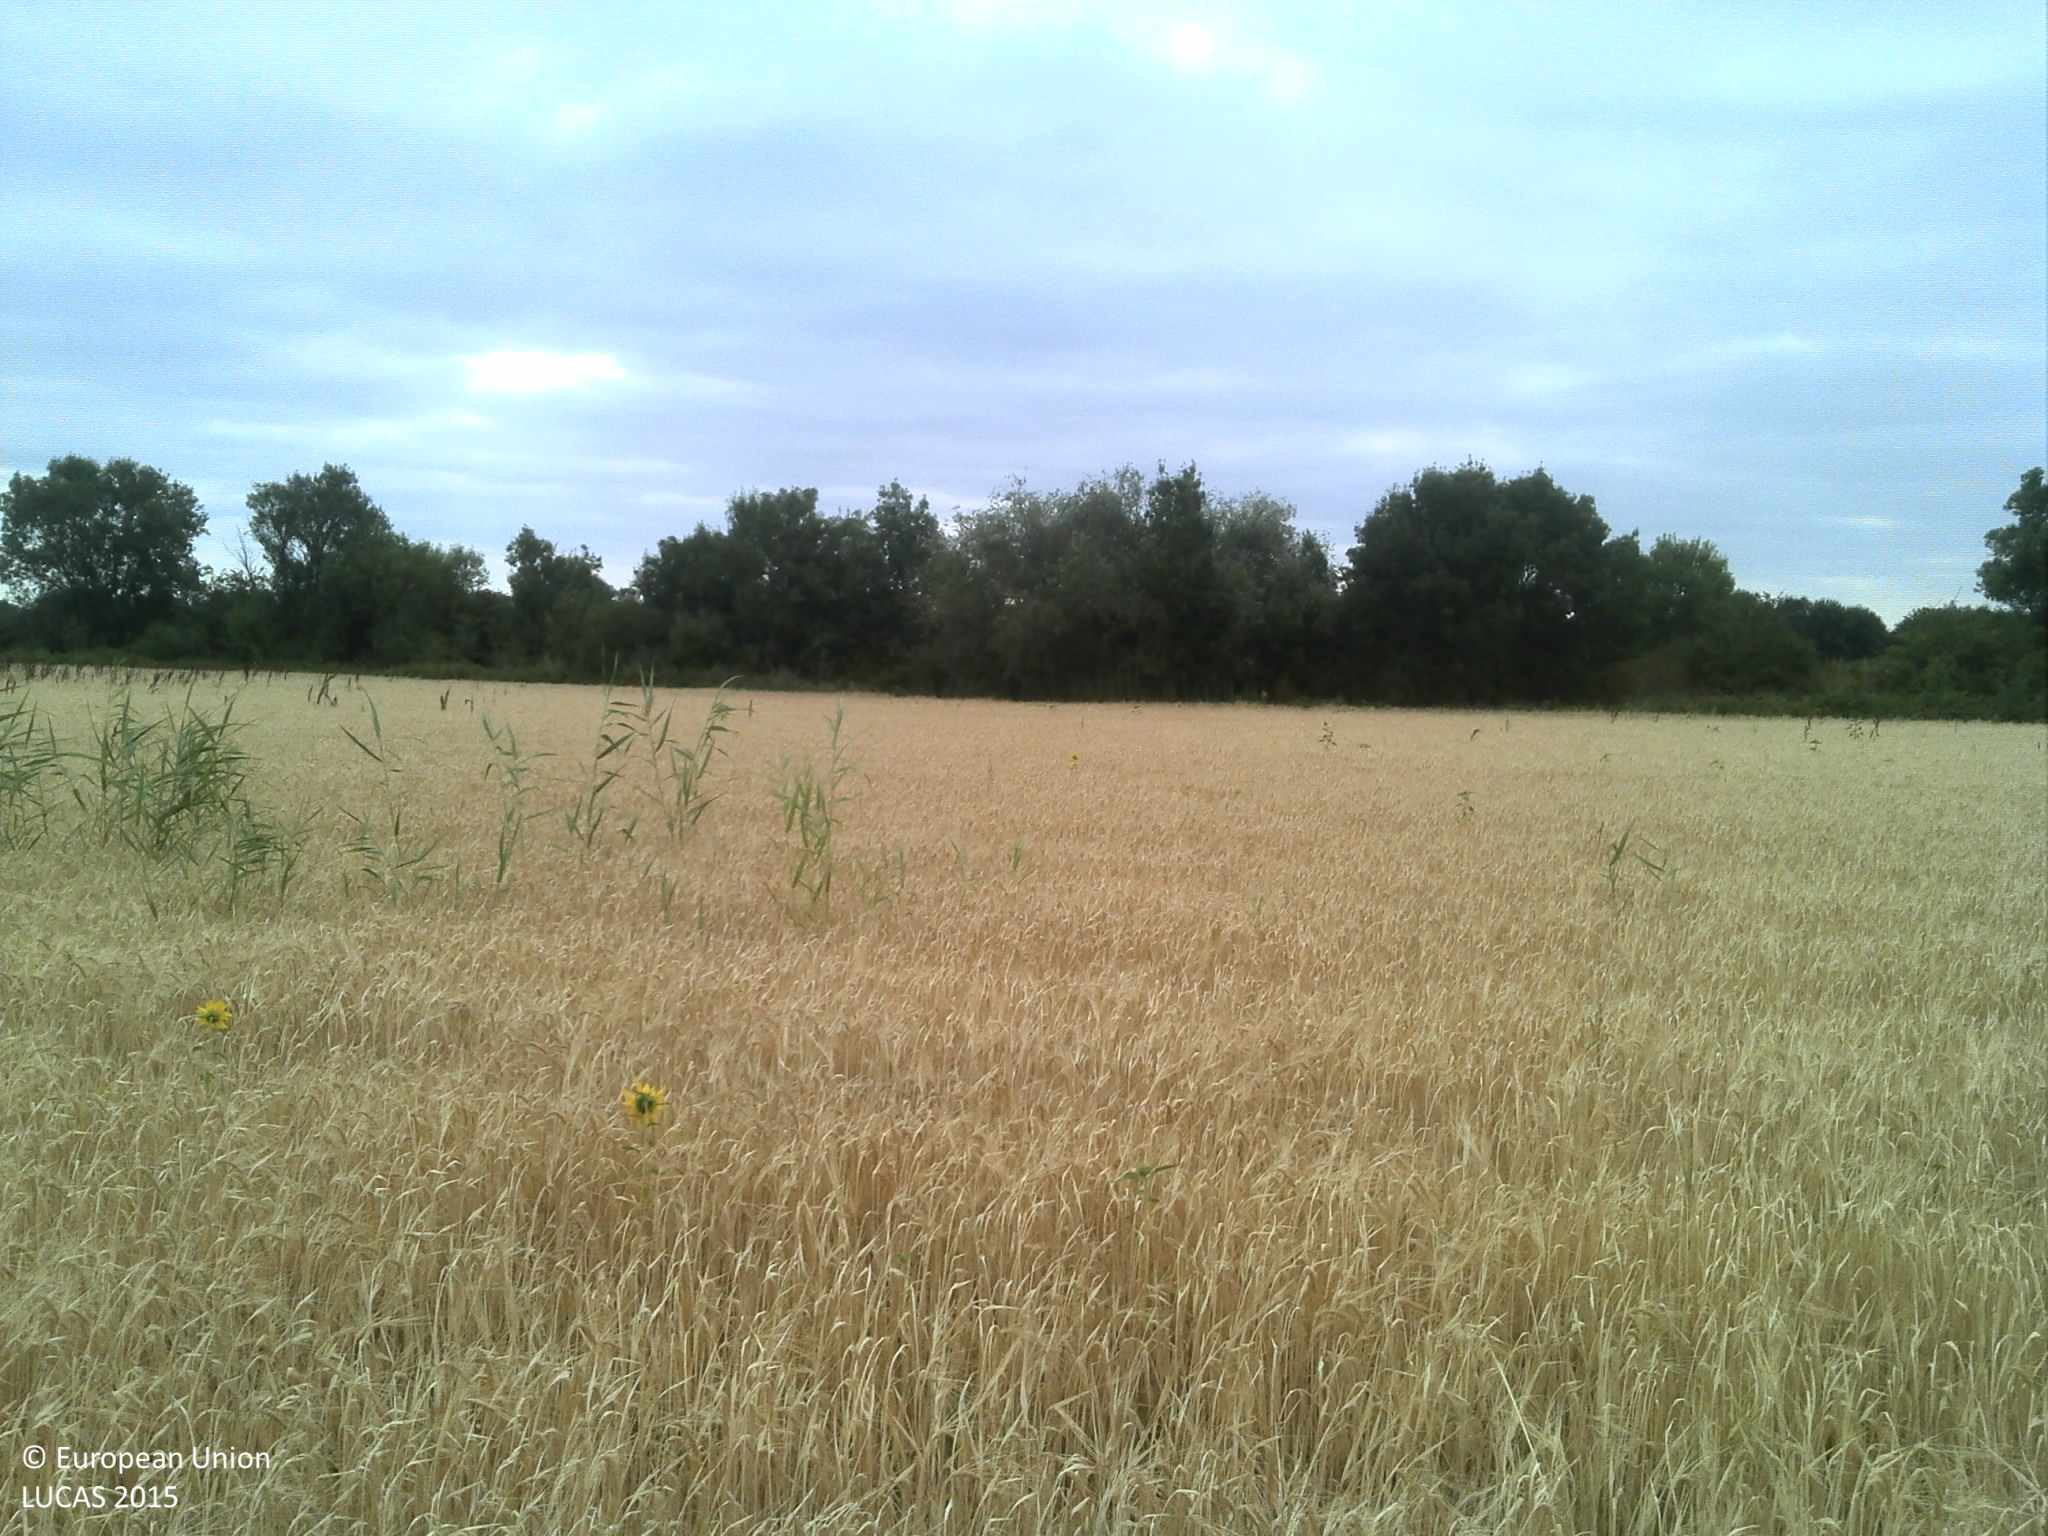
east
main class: Cropland
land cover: Common wheat
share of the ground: > 75 %
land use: Agriculture (excluding fallow land and kitchen gardens)
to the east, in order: Common wheat; Shruby margins; Ditches and canals; Abandoned hedges; Tracks; Spontaneously vegetated surfaces; Maize
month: June
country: PT
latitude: 39.2528
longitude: -8.6713
